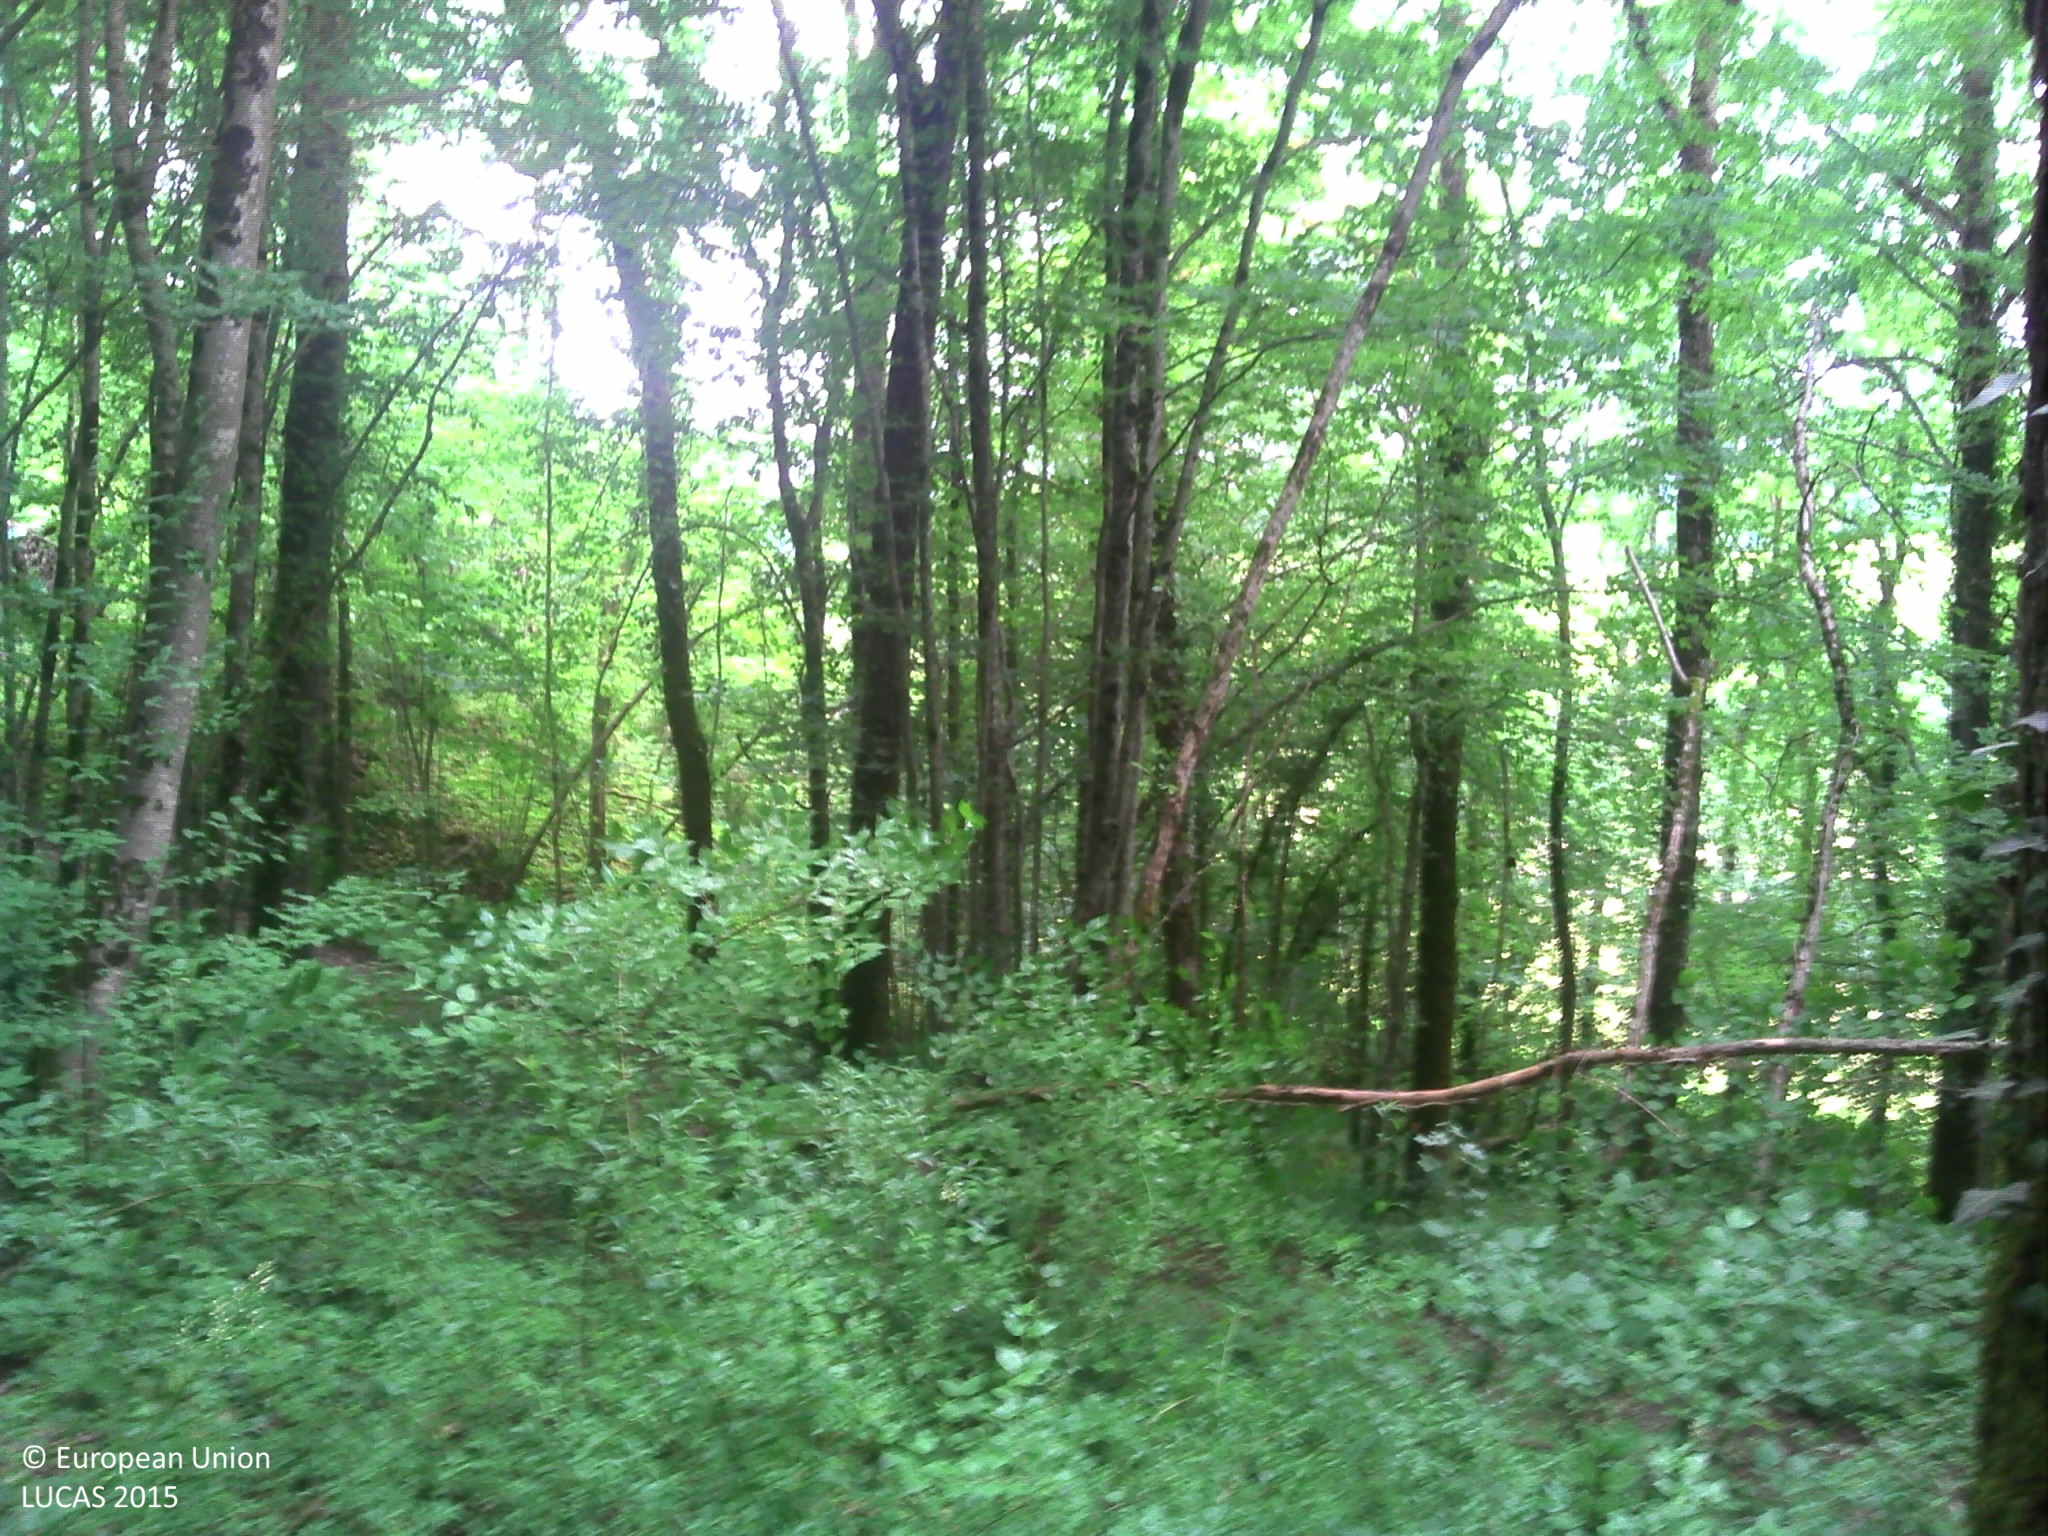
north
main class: Woodland
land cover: Broadleaved woodland
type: acidophilous oak and oak-birch forest
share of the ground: > 75 %
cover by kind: broadleaved forest trees 90 %, herbaceous plants 10 %
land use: Forestry
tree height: > 5 m
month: June
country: FR
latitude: 48.2341
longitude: 4.9499
